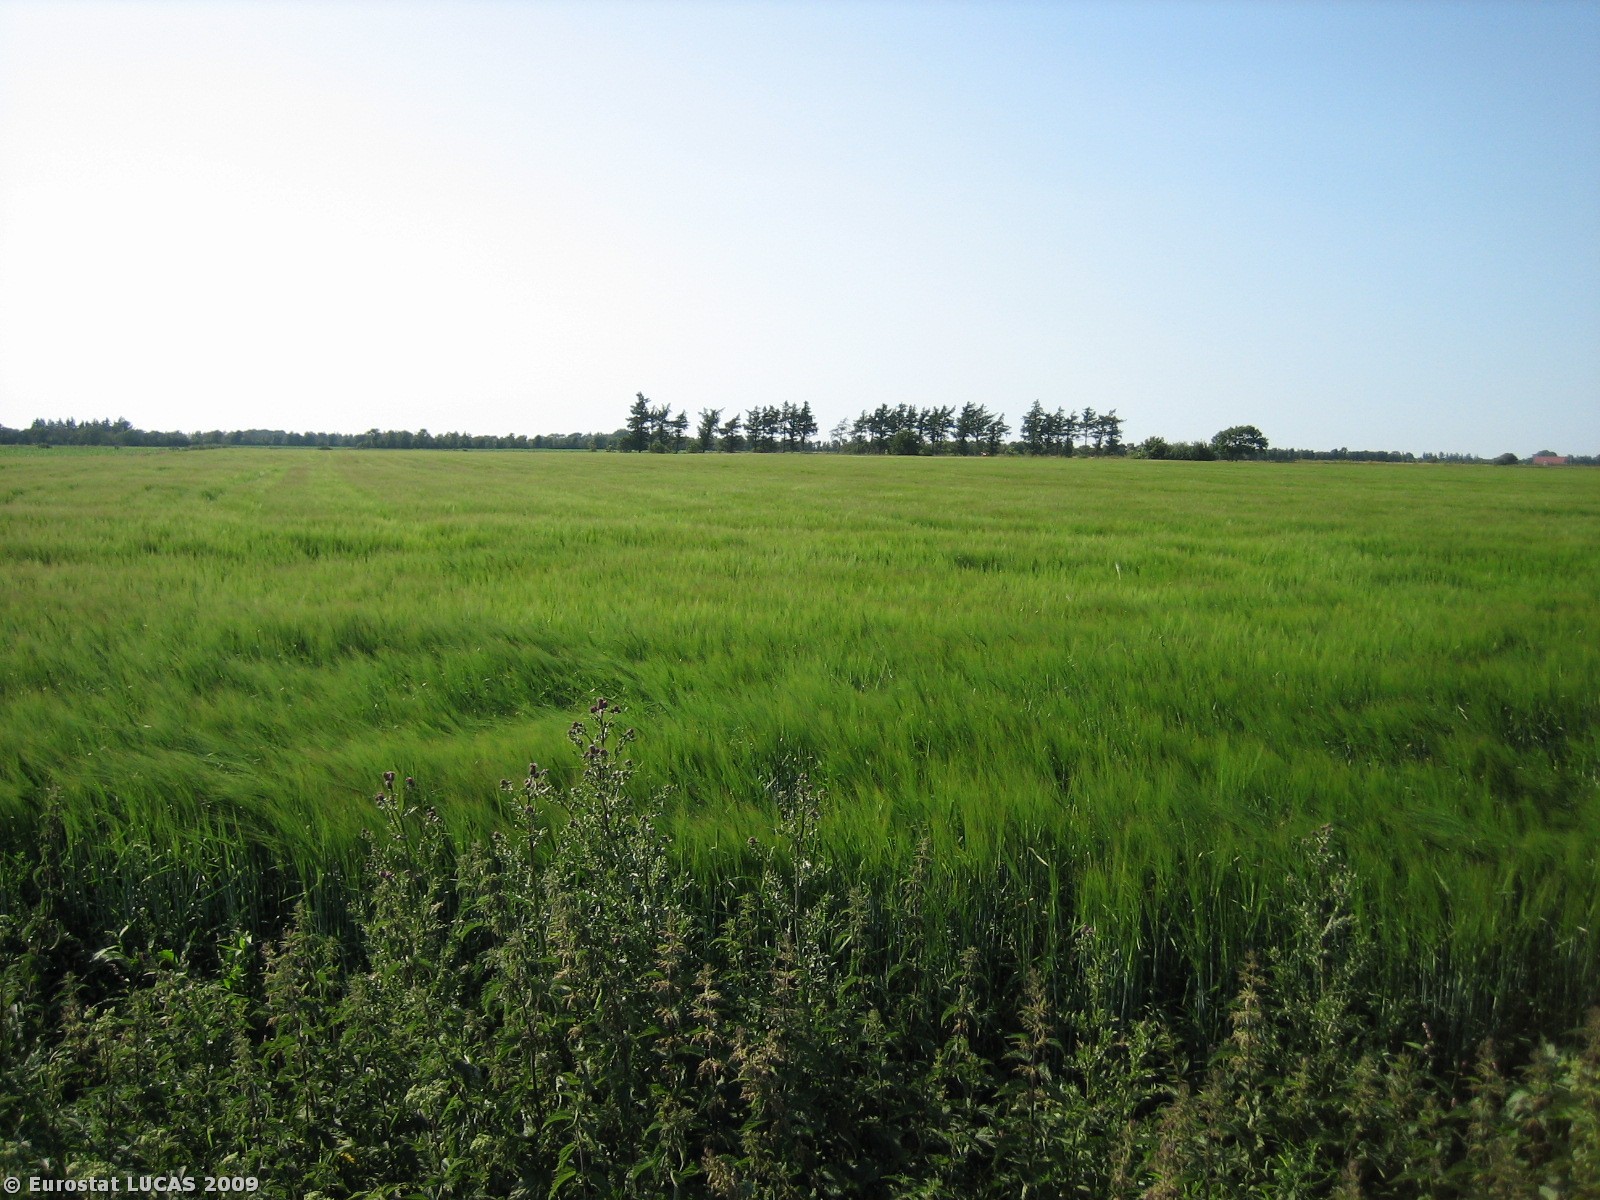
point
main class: Cropland
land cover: Barley
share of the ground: > 75 %
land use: Agriculture (excluding fallow land and kitchen gardens)
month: July
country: DK
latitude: 55.3736
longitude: 8.8491
